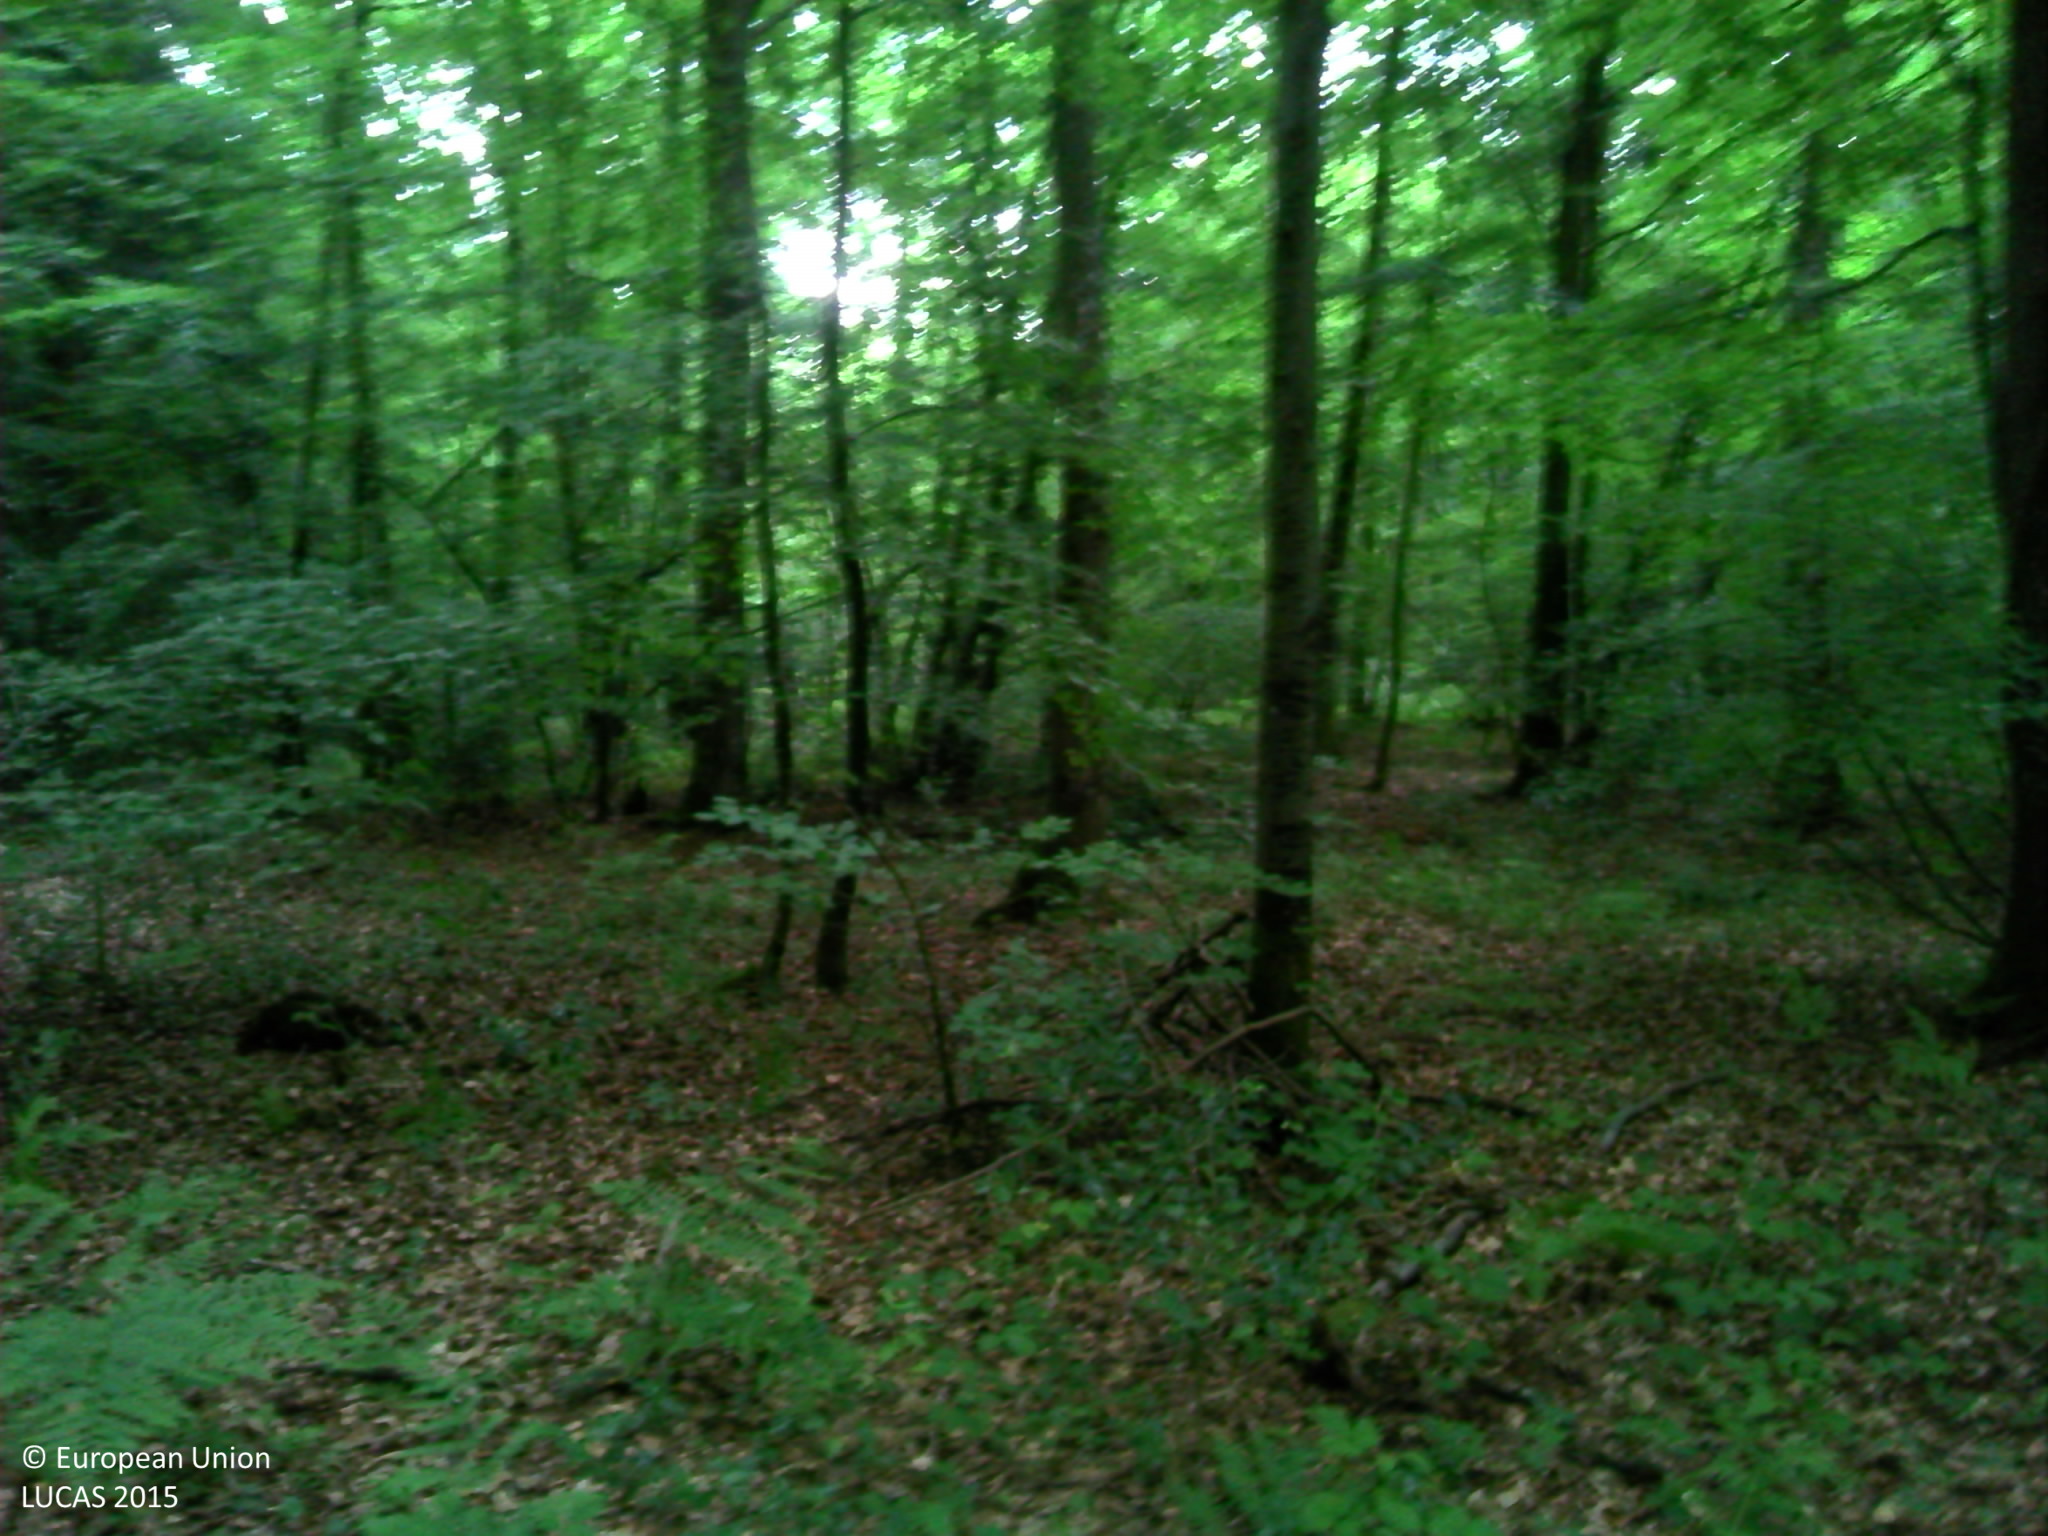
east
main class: Woodland
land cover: Broadleaved woodland
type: acidophilous oak and oak-birch forest
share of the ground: > 75 %
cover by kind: broadleaved forest trees 75 %, coniferous forest trees 10 %, herbaceous plants 10 %, shrubs 5 %
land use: Forestry
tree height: > 5 m
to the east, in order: Broadleaved woodland; Ditches and canals; Grass margins; Paved roads, cycling and walking lanes; Grass margins; Fences; Electric lines; Broadleaved woodland
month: July
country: FR
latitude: 48.9345
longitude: 0.0732
